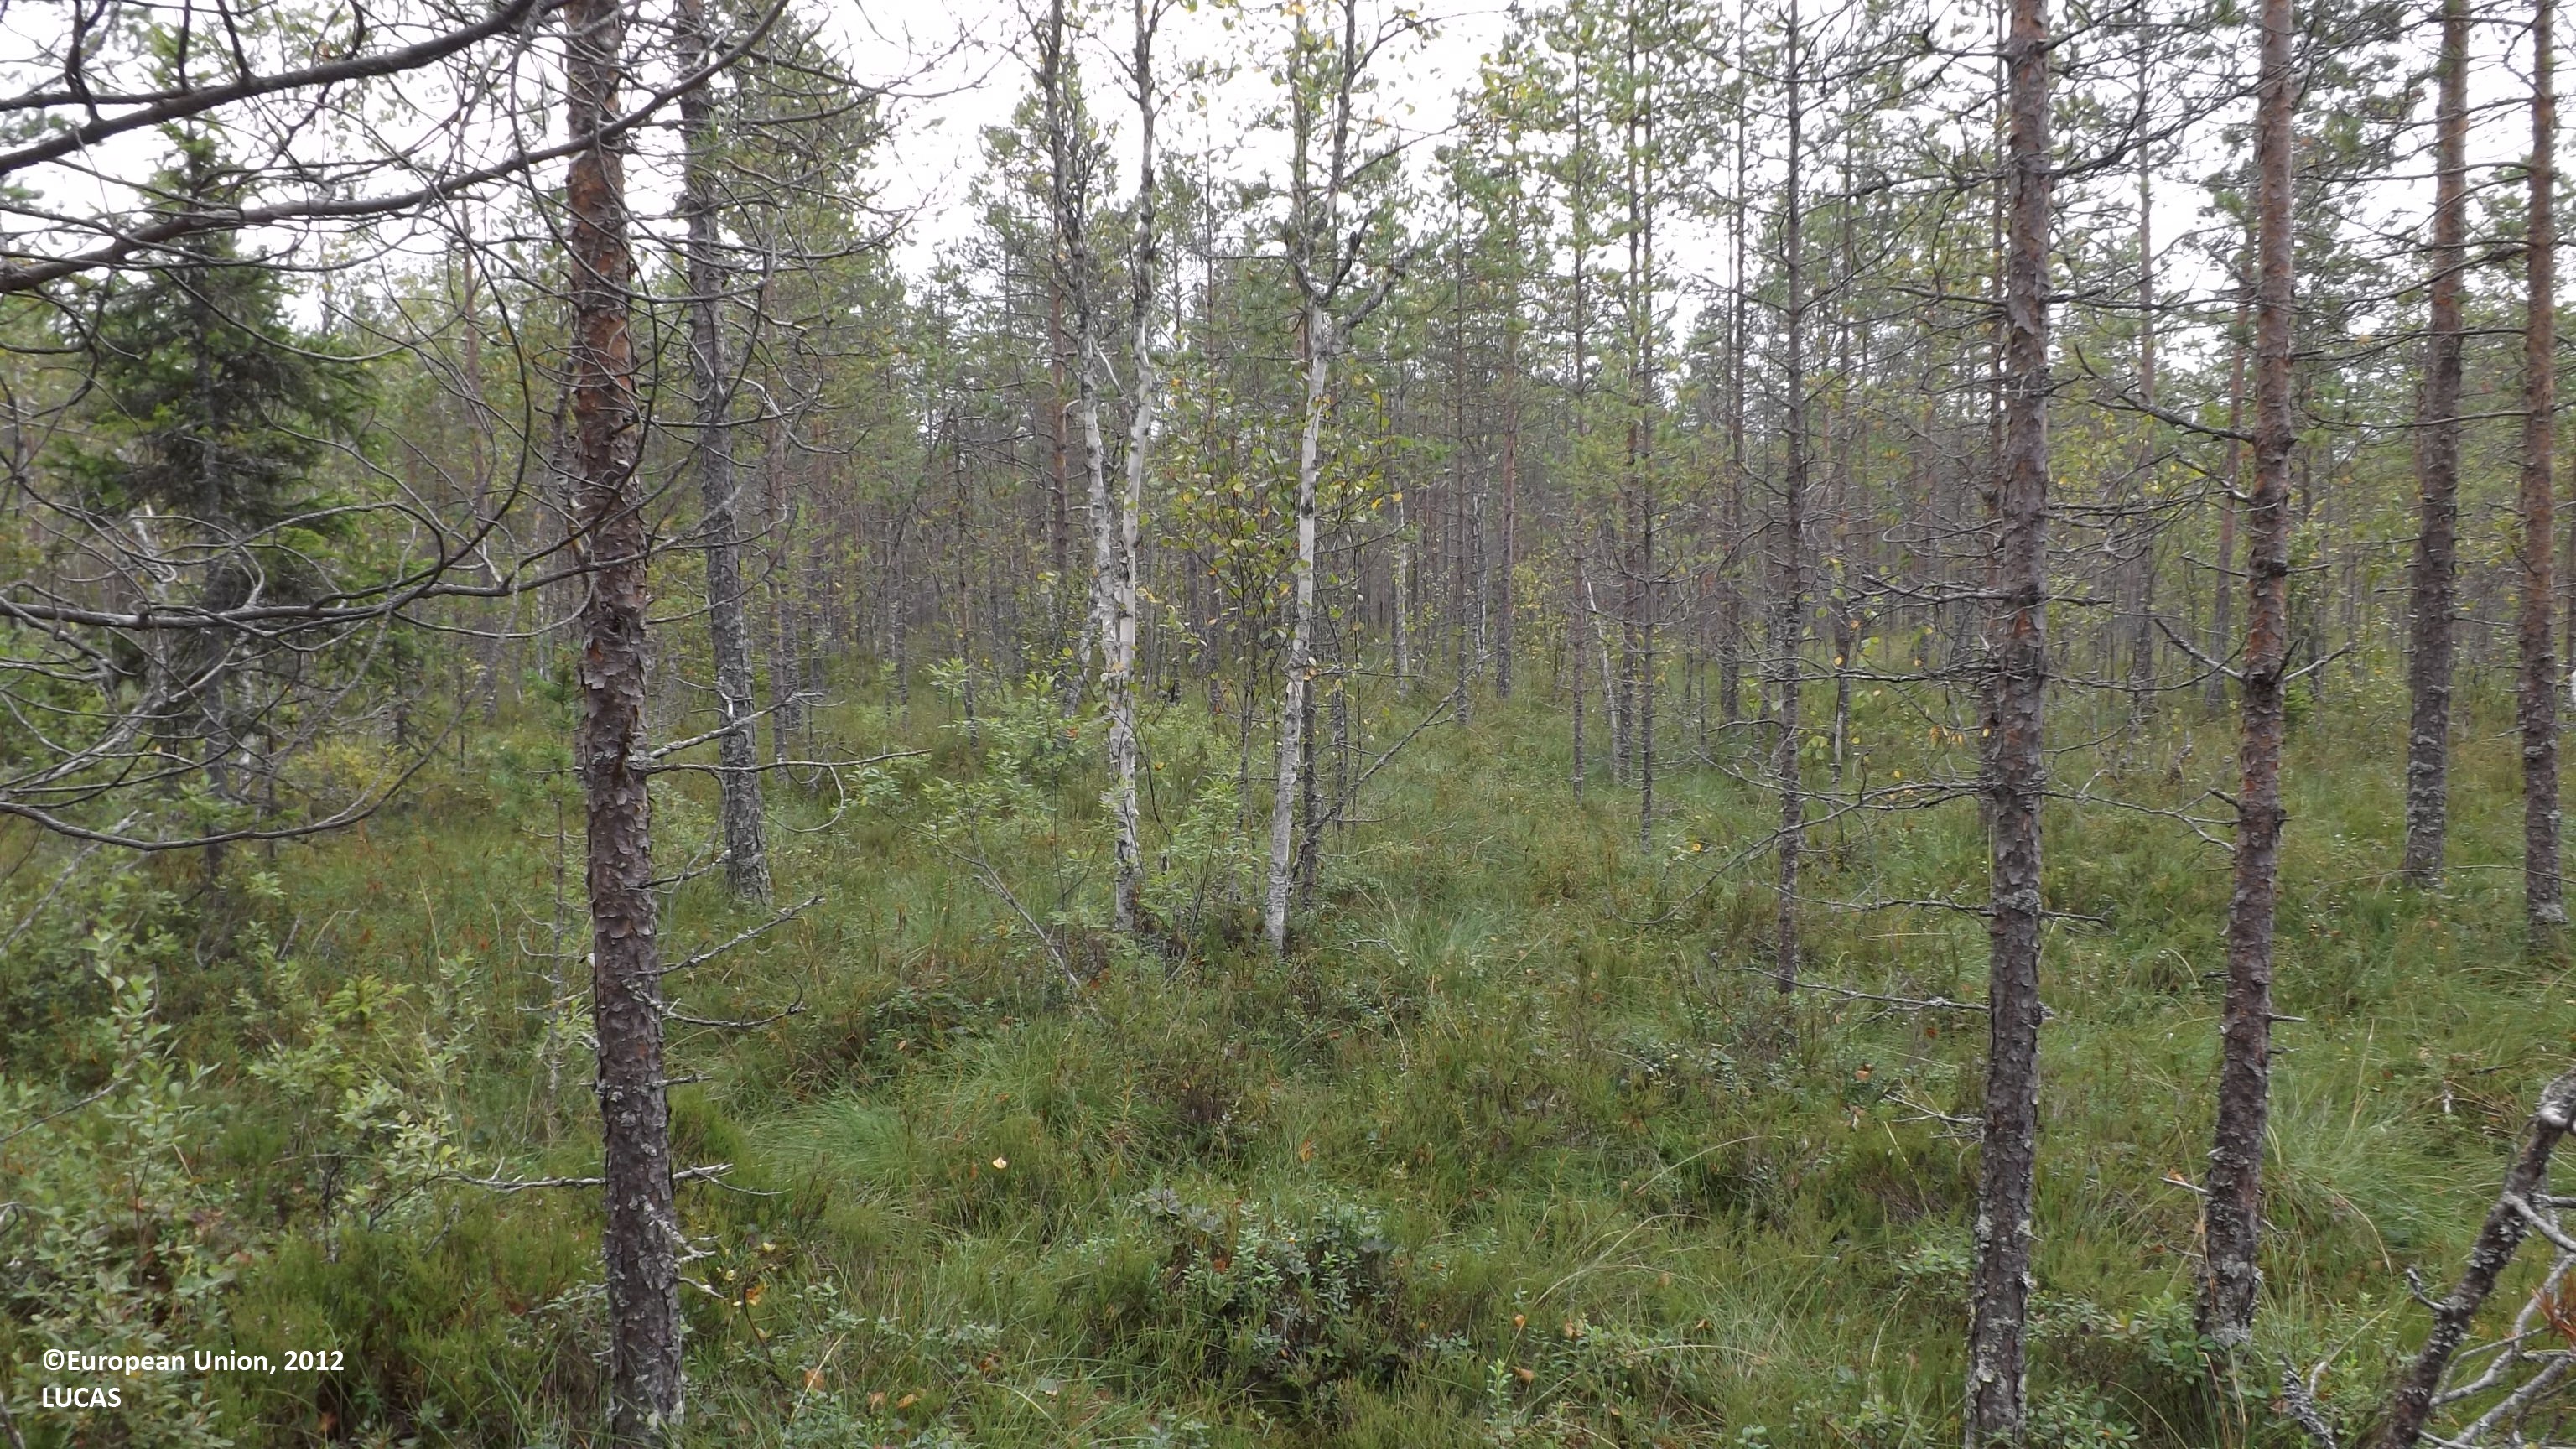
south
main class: Woodland
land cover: Pine dominated mixed woodland
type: mire and swamp forests
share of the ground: 25 - 50 %
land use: Semi-natural and natural areas not in use
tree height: > 5 m
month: August
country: FI
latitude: 63.7030
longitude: 23.9669
